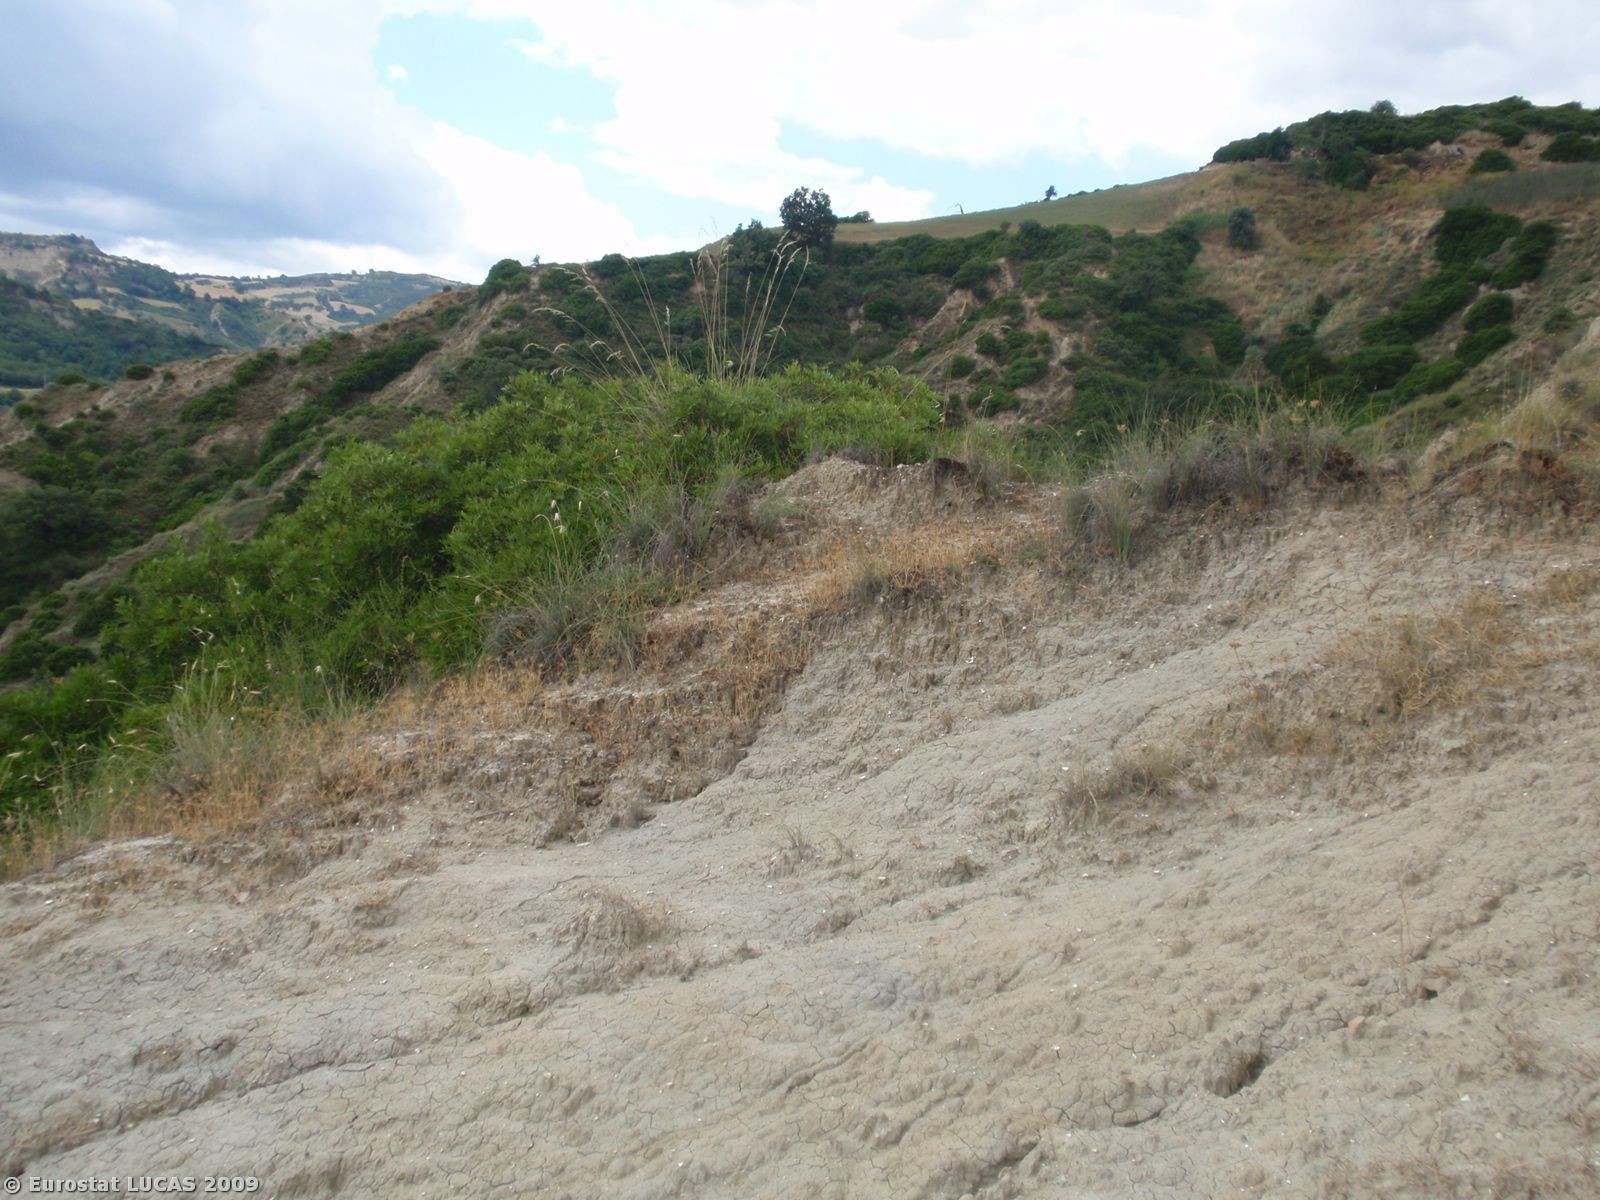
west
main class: Shrubland
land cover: Shrubland with sparse tree cover
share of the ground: > 75 %
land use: Agriculture (excluding fallow land and kitchen gardens)
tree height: < 5 m
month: June
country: IT
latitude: 40.2124
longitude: 16.2608
